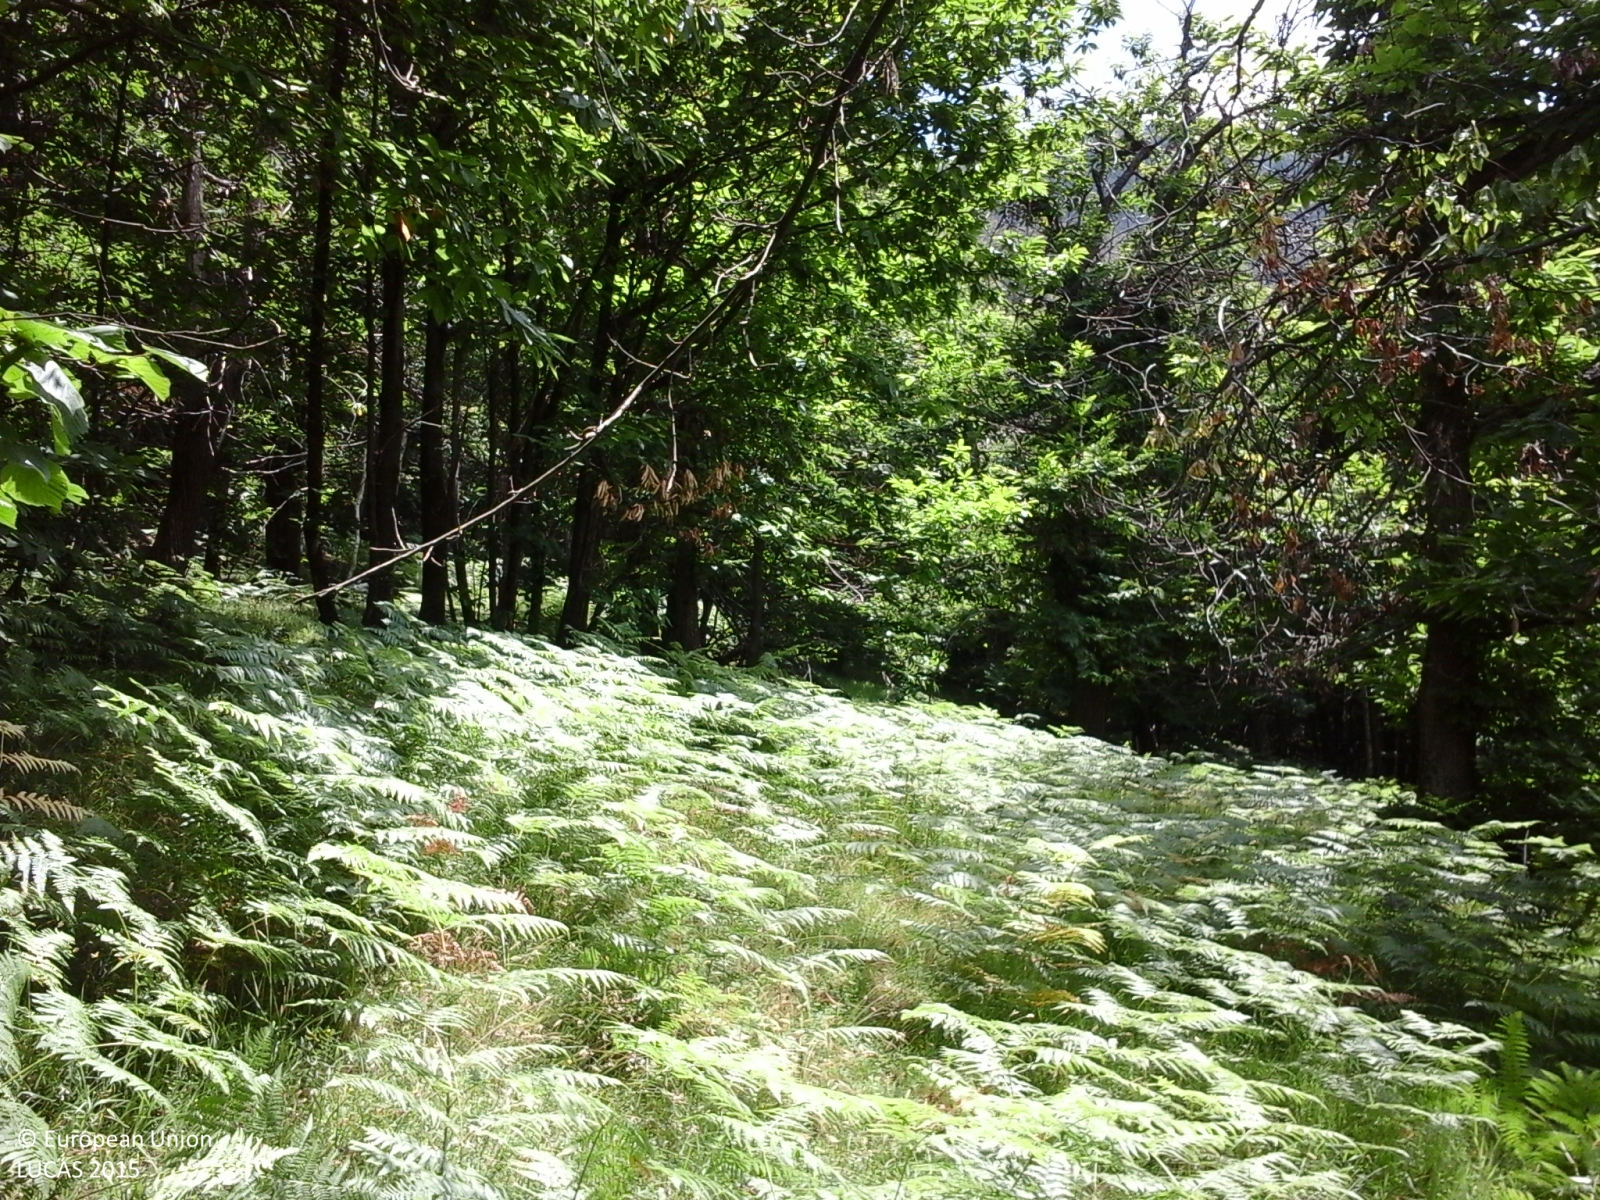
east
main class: Woodland
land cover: Broadleaved woodland
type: thermophilous deciduous forest
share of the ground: > 75 %
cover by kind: broadleaved forest trees 100 %
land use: Semi-natural and natural areas not in use
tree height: > 5 m
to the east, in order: Broadleaved woodland
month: June
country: IT
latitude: 44.3084
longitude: 7.7609
